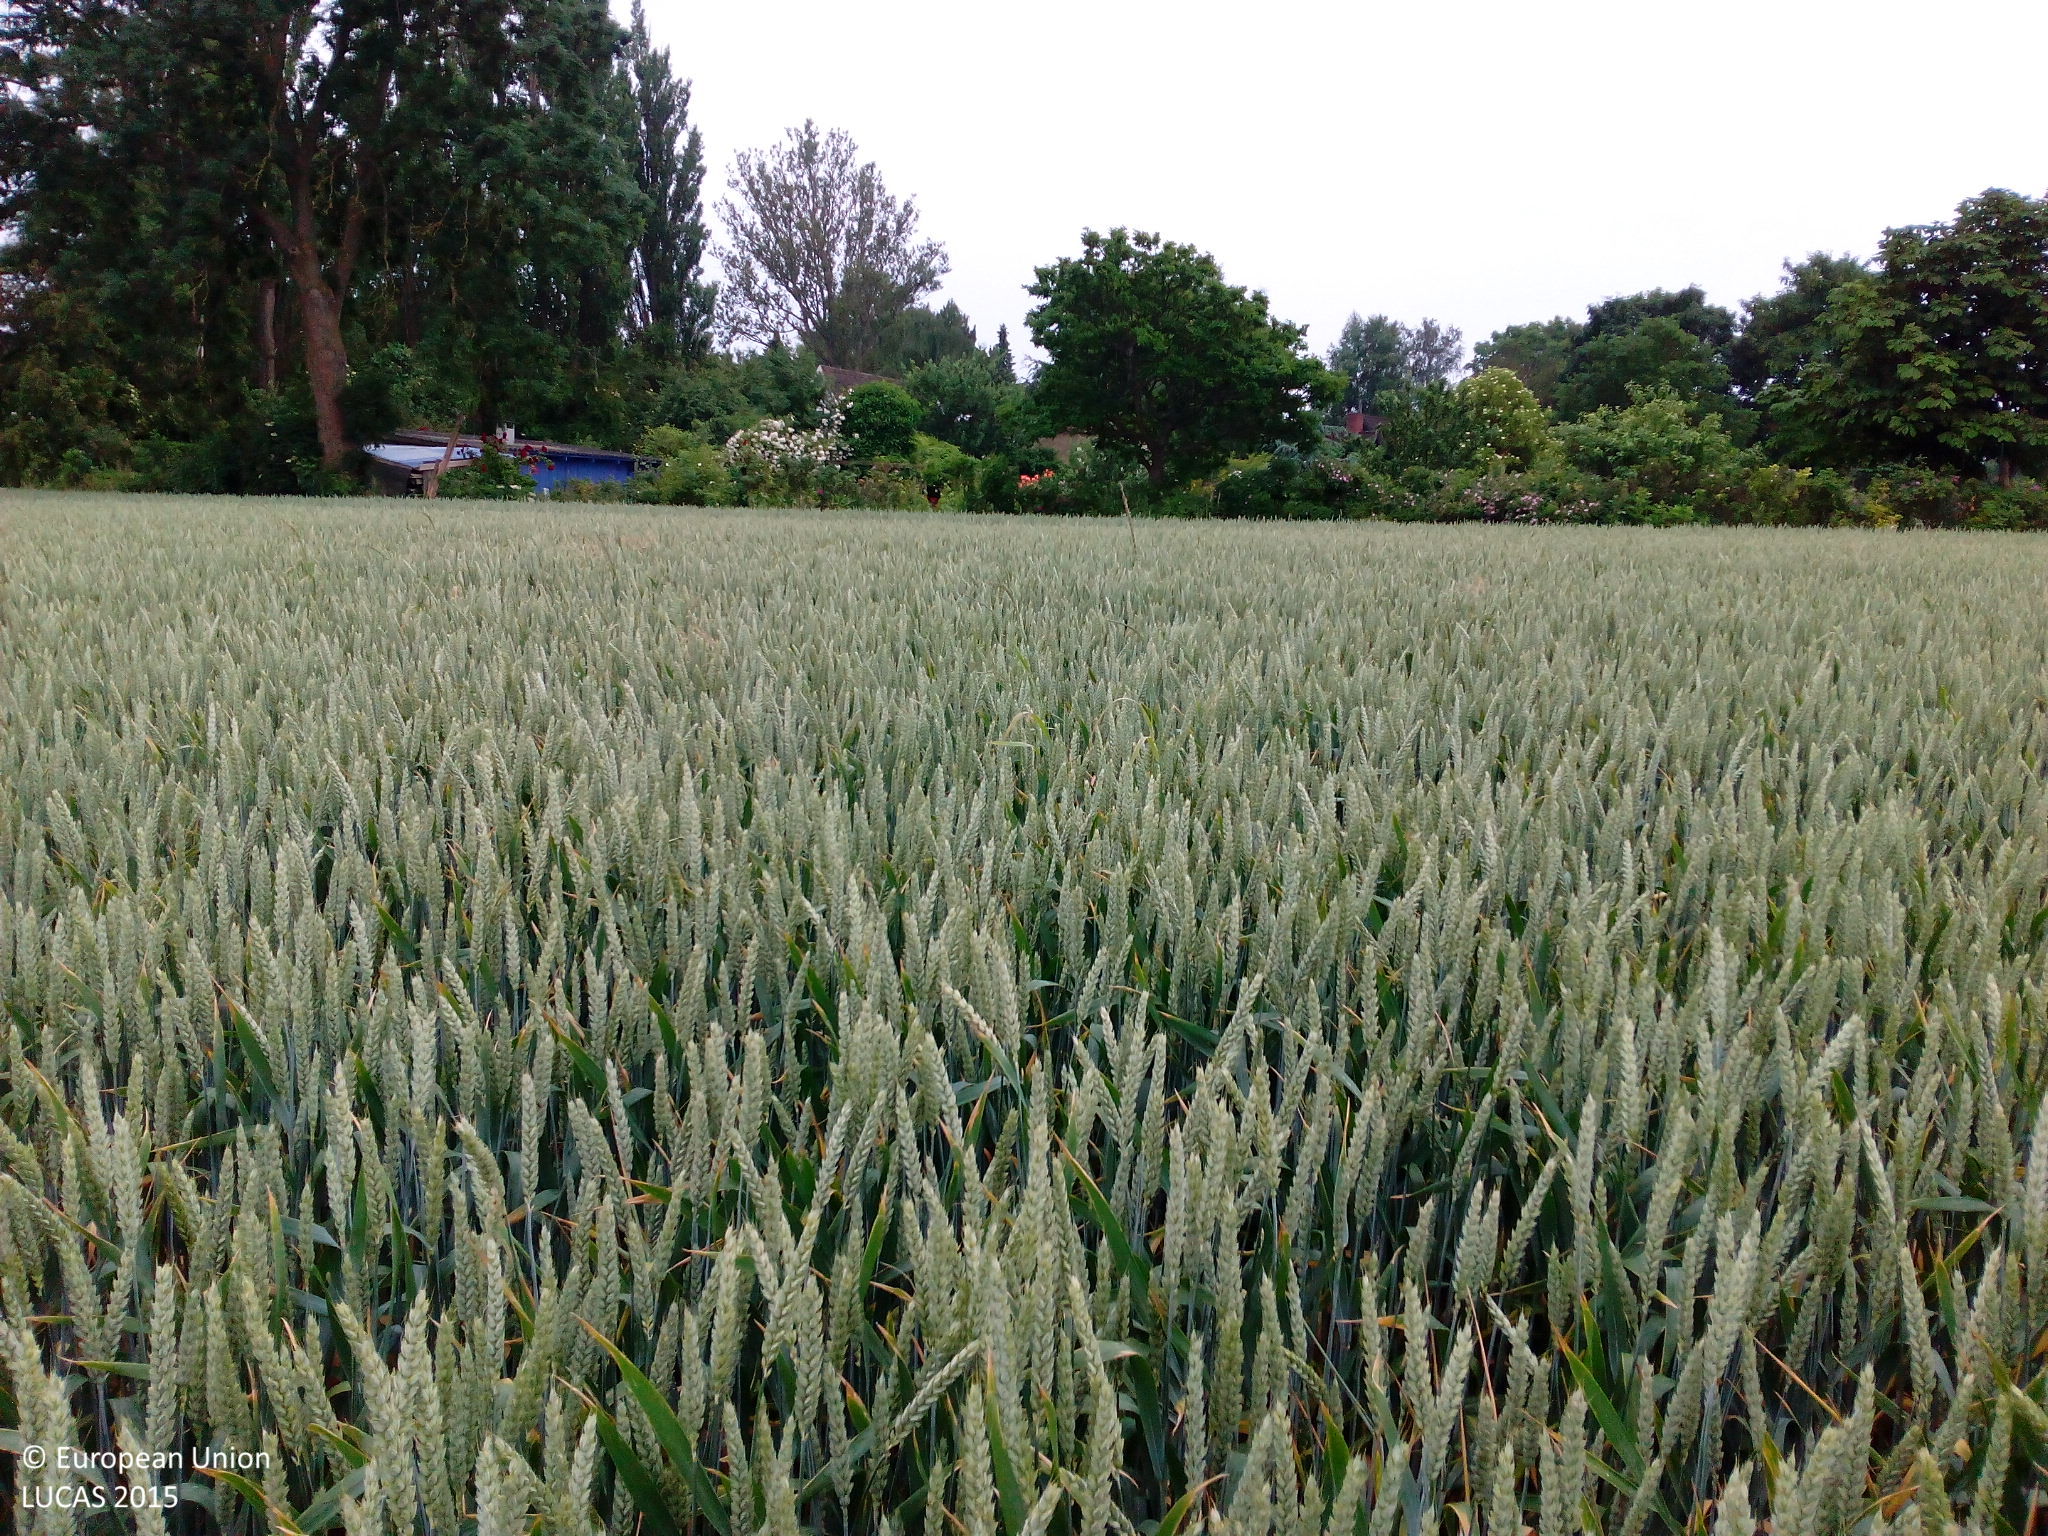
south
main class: Cropland
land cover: Common wheat
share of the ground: > 75 %
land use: Agriculture (excluding fallow land and kitchen gardens)
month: July
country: DK
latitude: 55.2255
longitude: 11.5552
